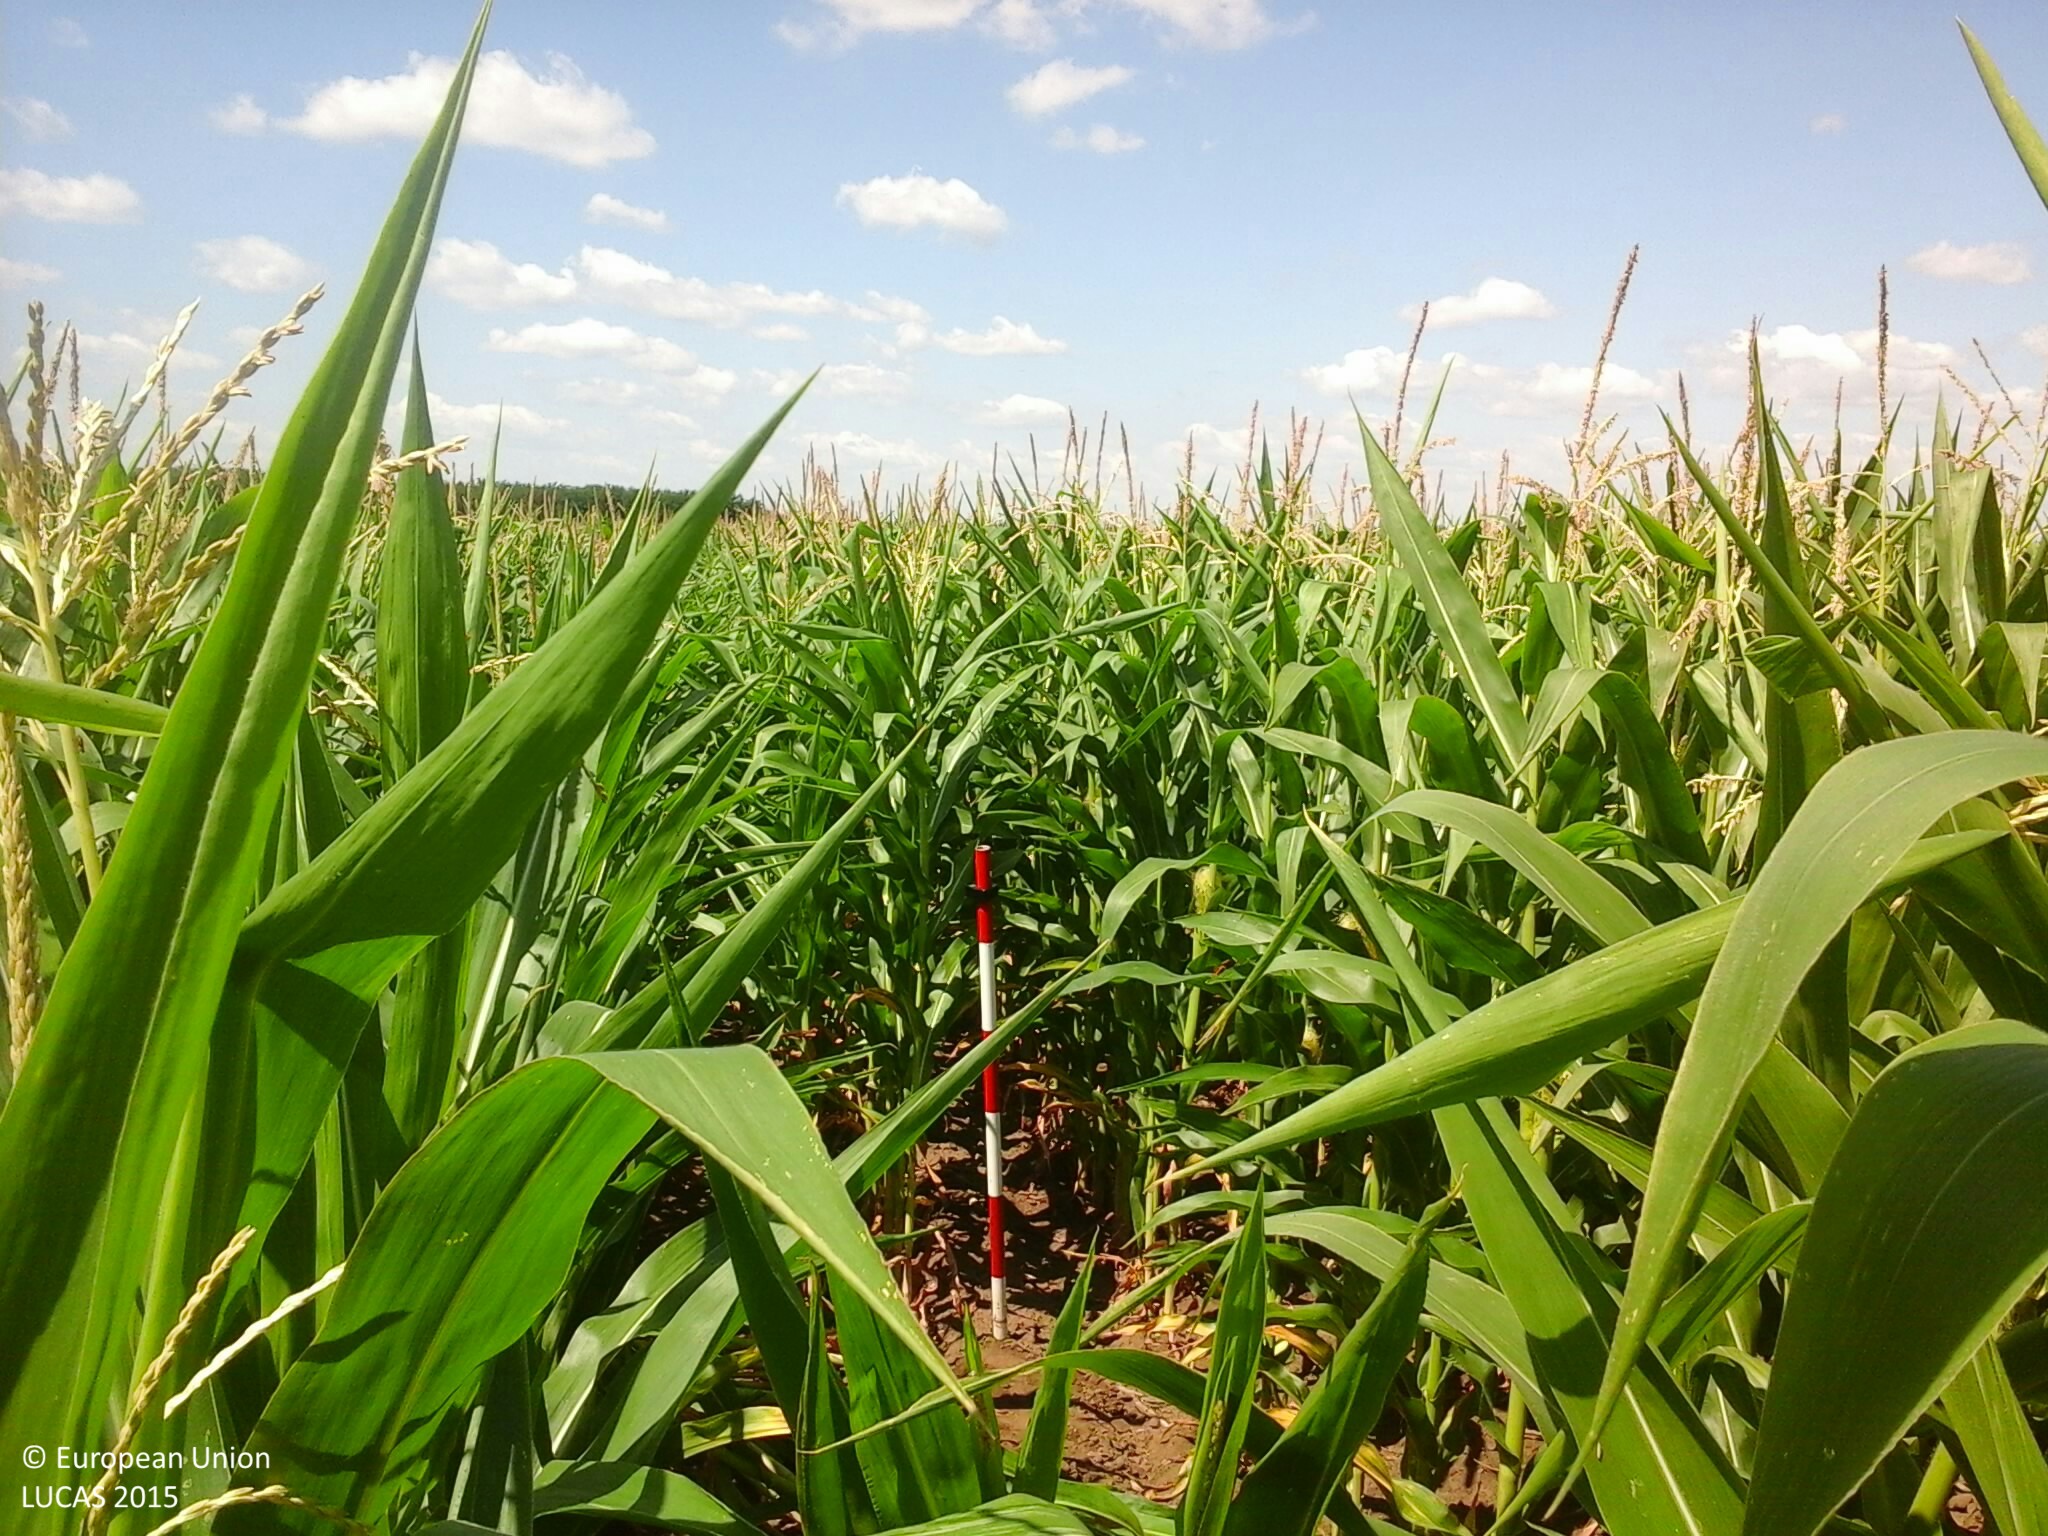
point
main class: Cropland
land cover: Maize
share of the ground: 50 - 75 %
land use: Agriculture (excluding fallow land and kitchen gardens)
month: July
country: HU
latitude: 47.8607
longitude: 21.9606
